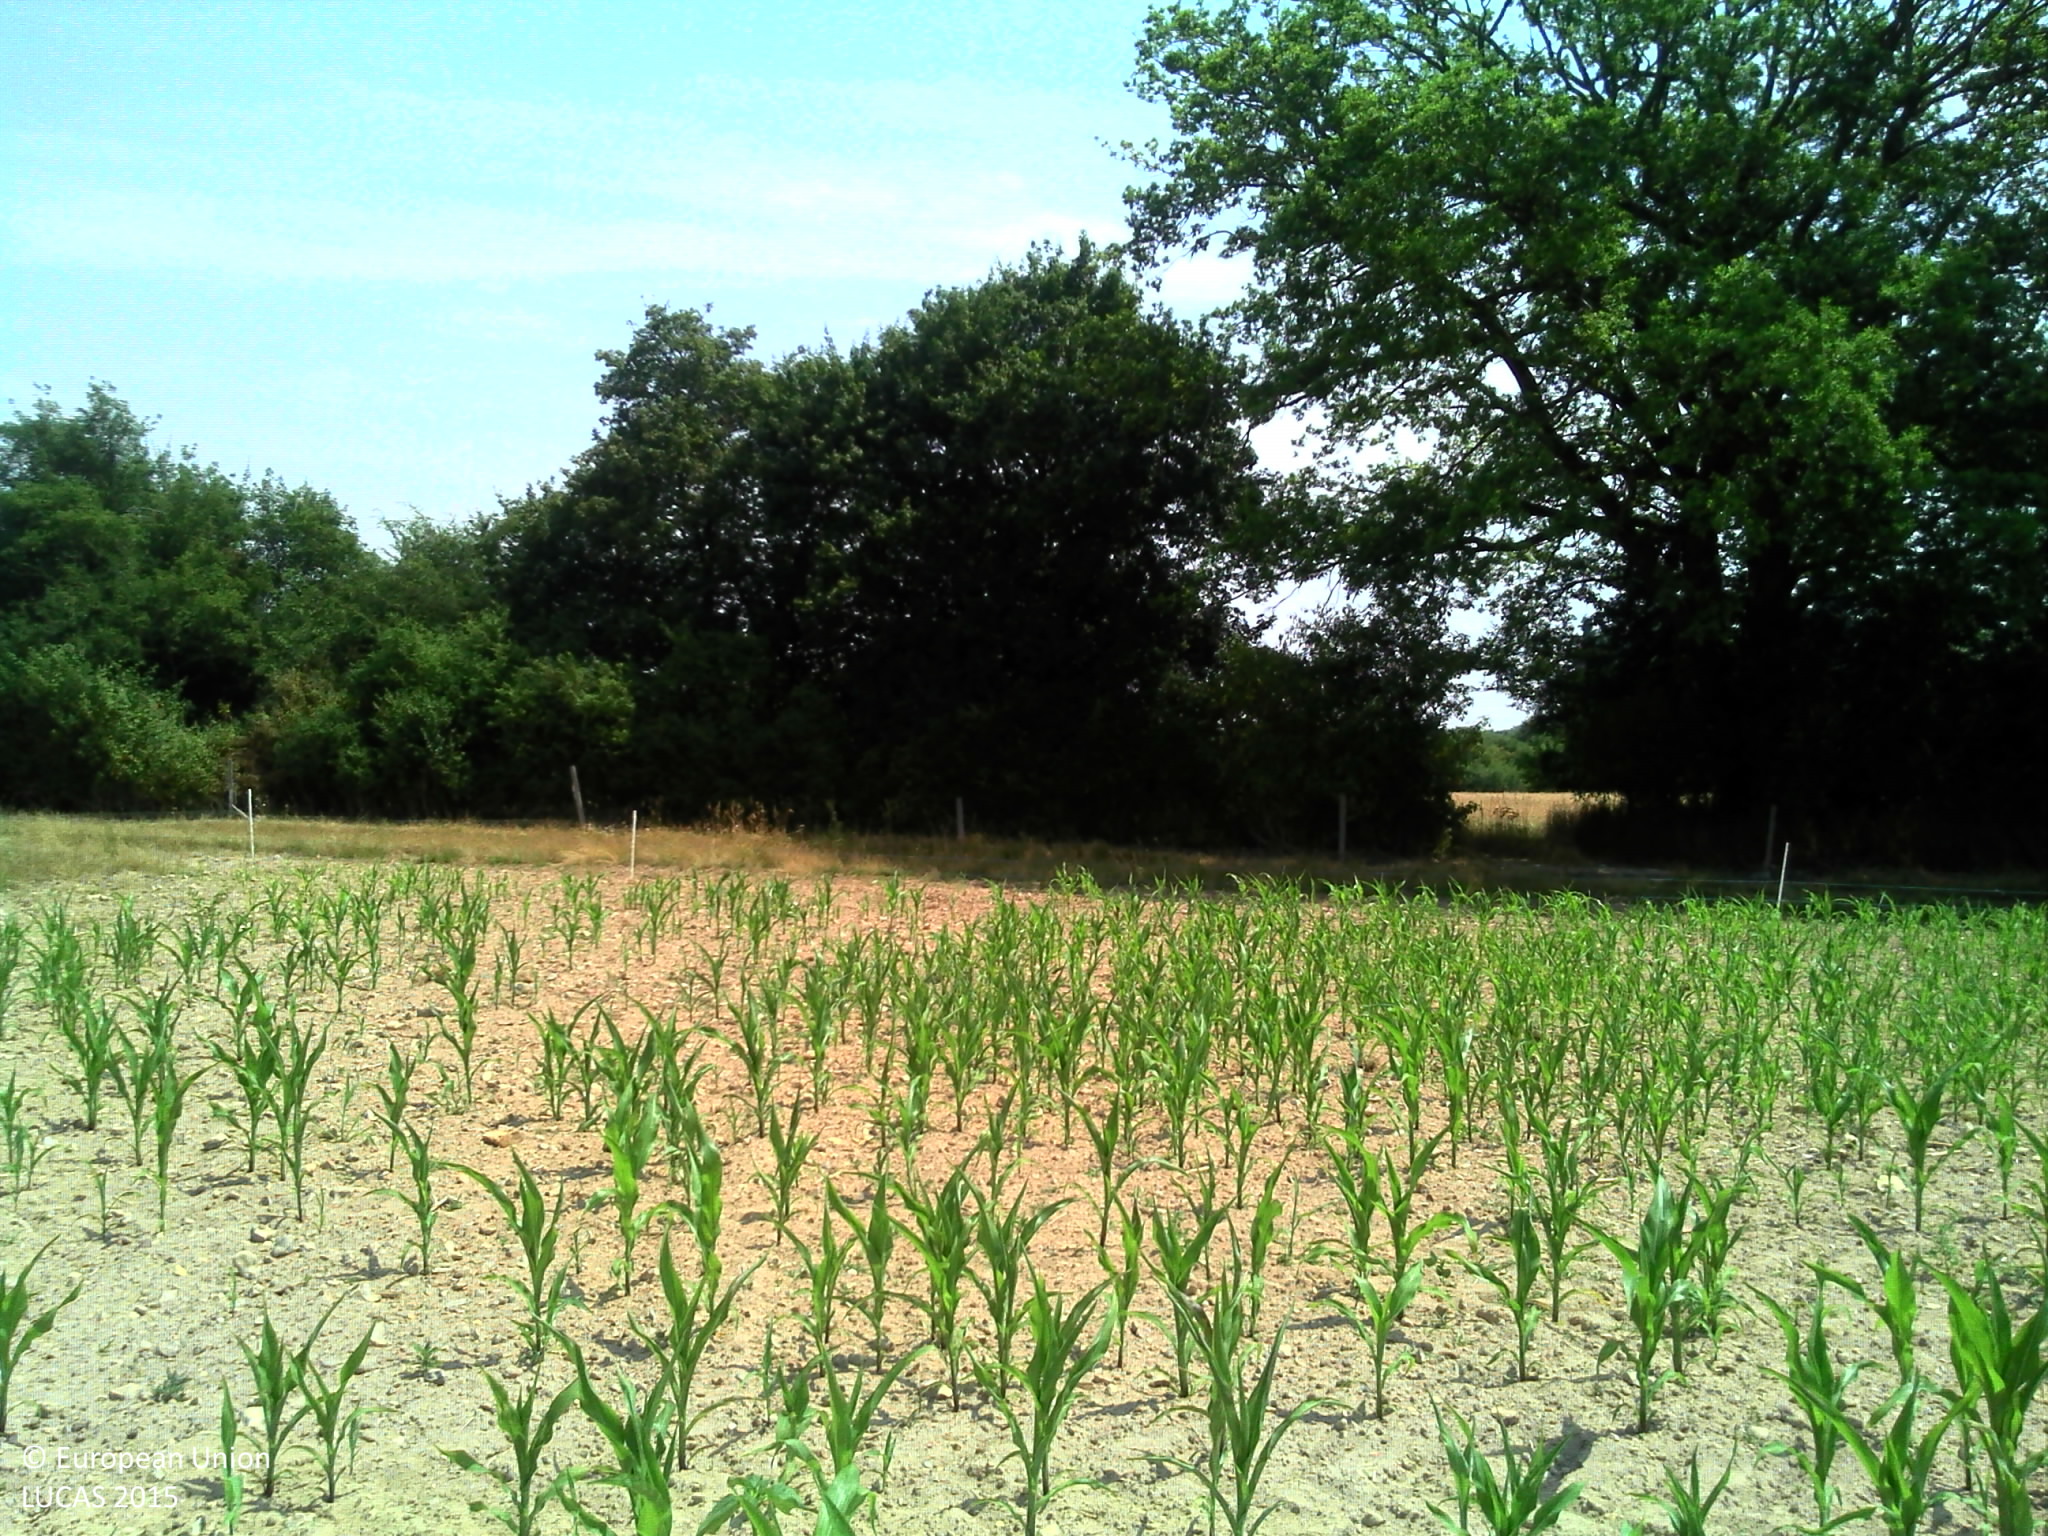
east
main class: Cropland
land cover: Maize
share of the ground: 10 - 25 %
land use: Agriculture (excluding fallow land and kitchen gardens)
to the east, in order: Maize; Fences; Grass margins; Tracks; Grass margins; Fences; Lines of trees; Grassland without tree/shrub cover; Abandoned hedges; Tracks; Lines of trees; Grassland without tree/shrub cover
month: July
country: FR
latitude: 47.7909
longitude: 2.8243
